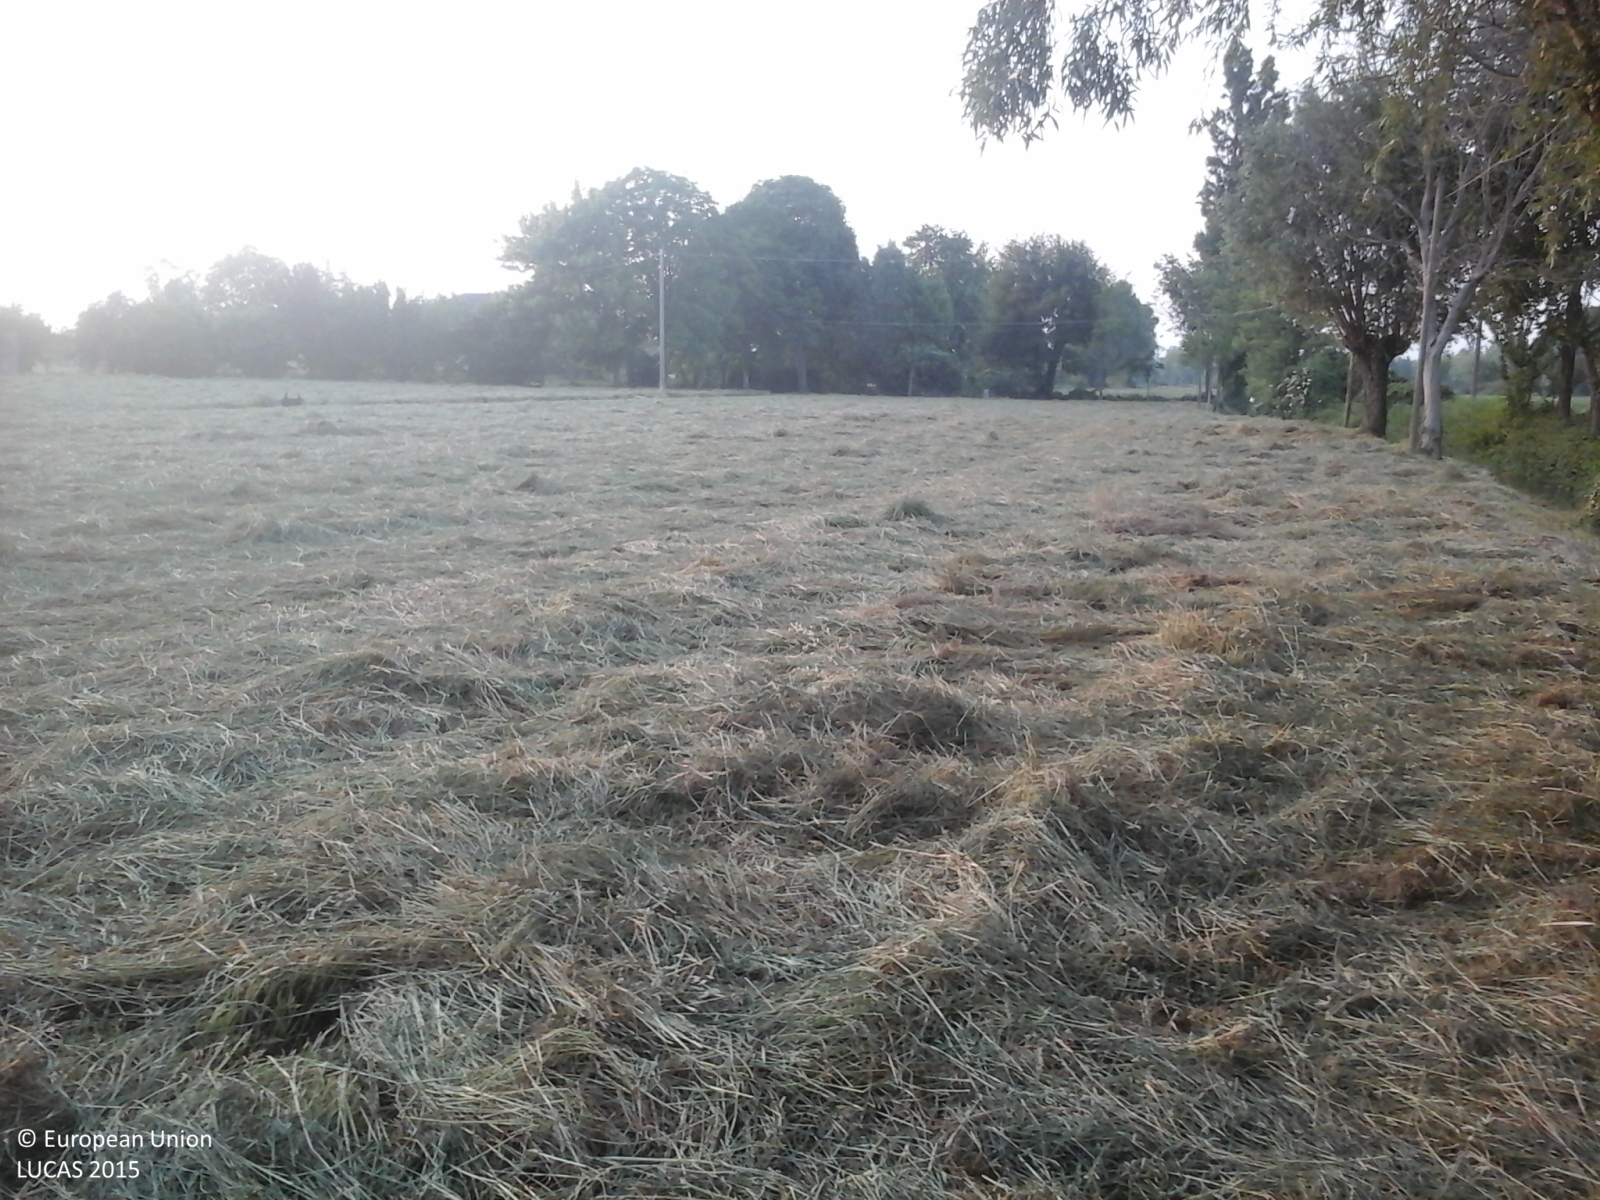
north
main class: Grassland
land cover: Grassland without tree/shrub cover
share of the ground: > 75 %
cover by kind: herbaceous plants 100 %
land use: Agriculture (excluding fallow land and kitchen gardens)
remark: Harvested field
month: May
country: IT
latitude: 45.3595
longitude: 10.3950
